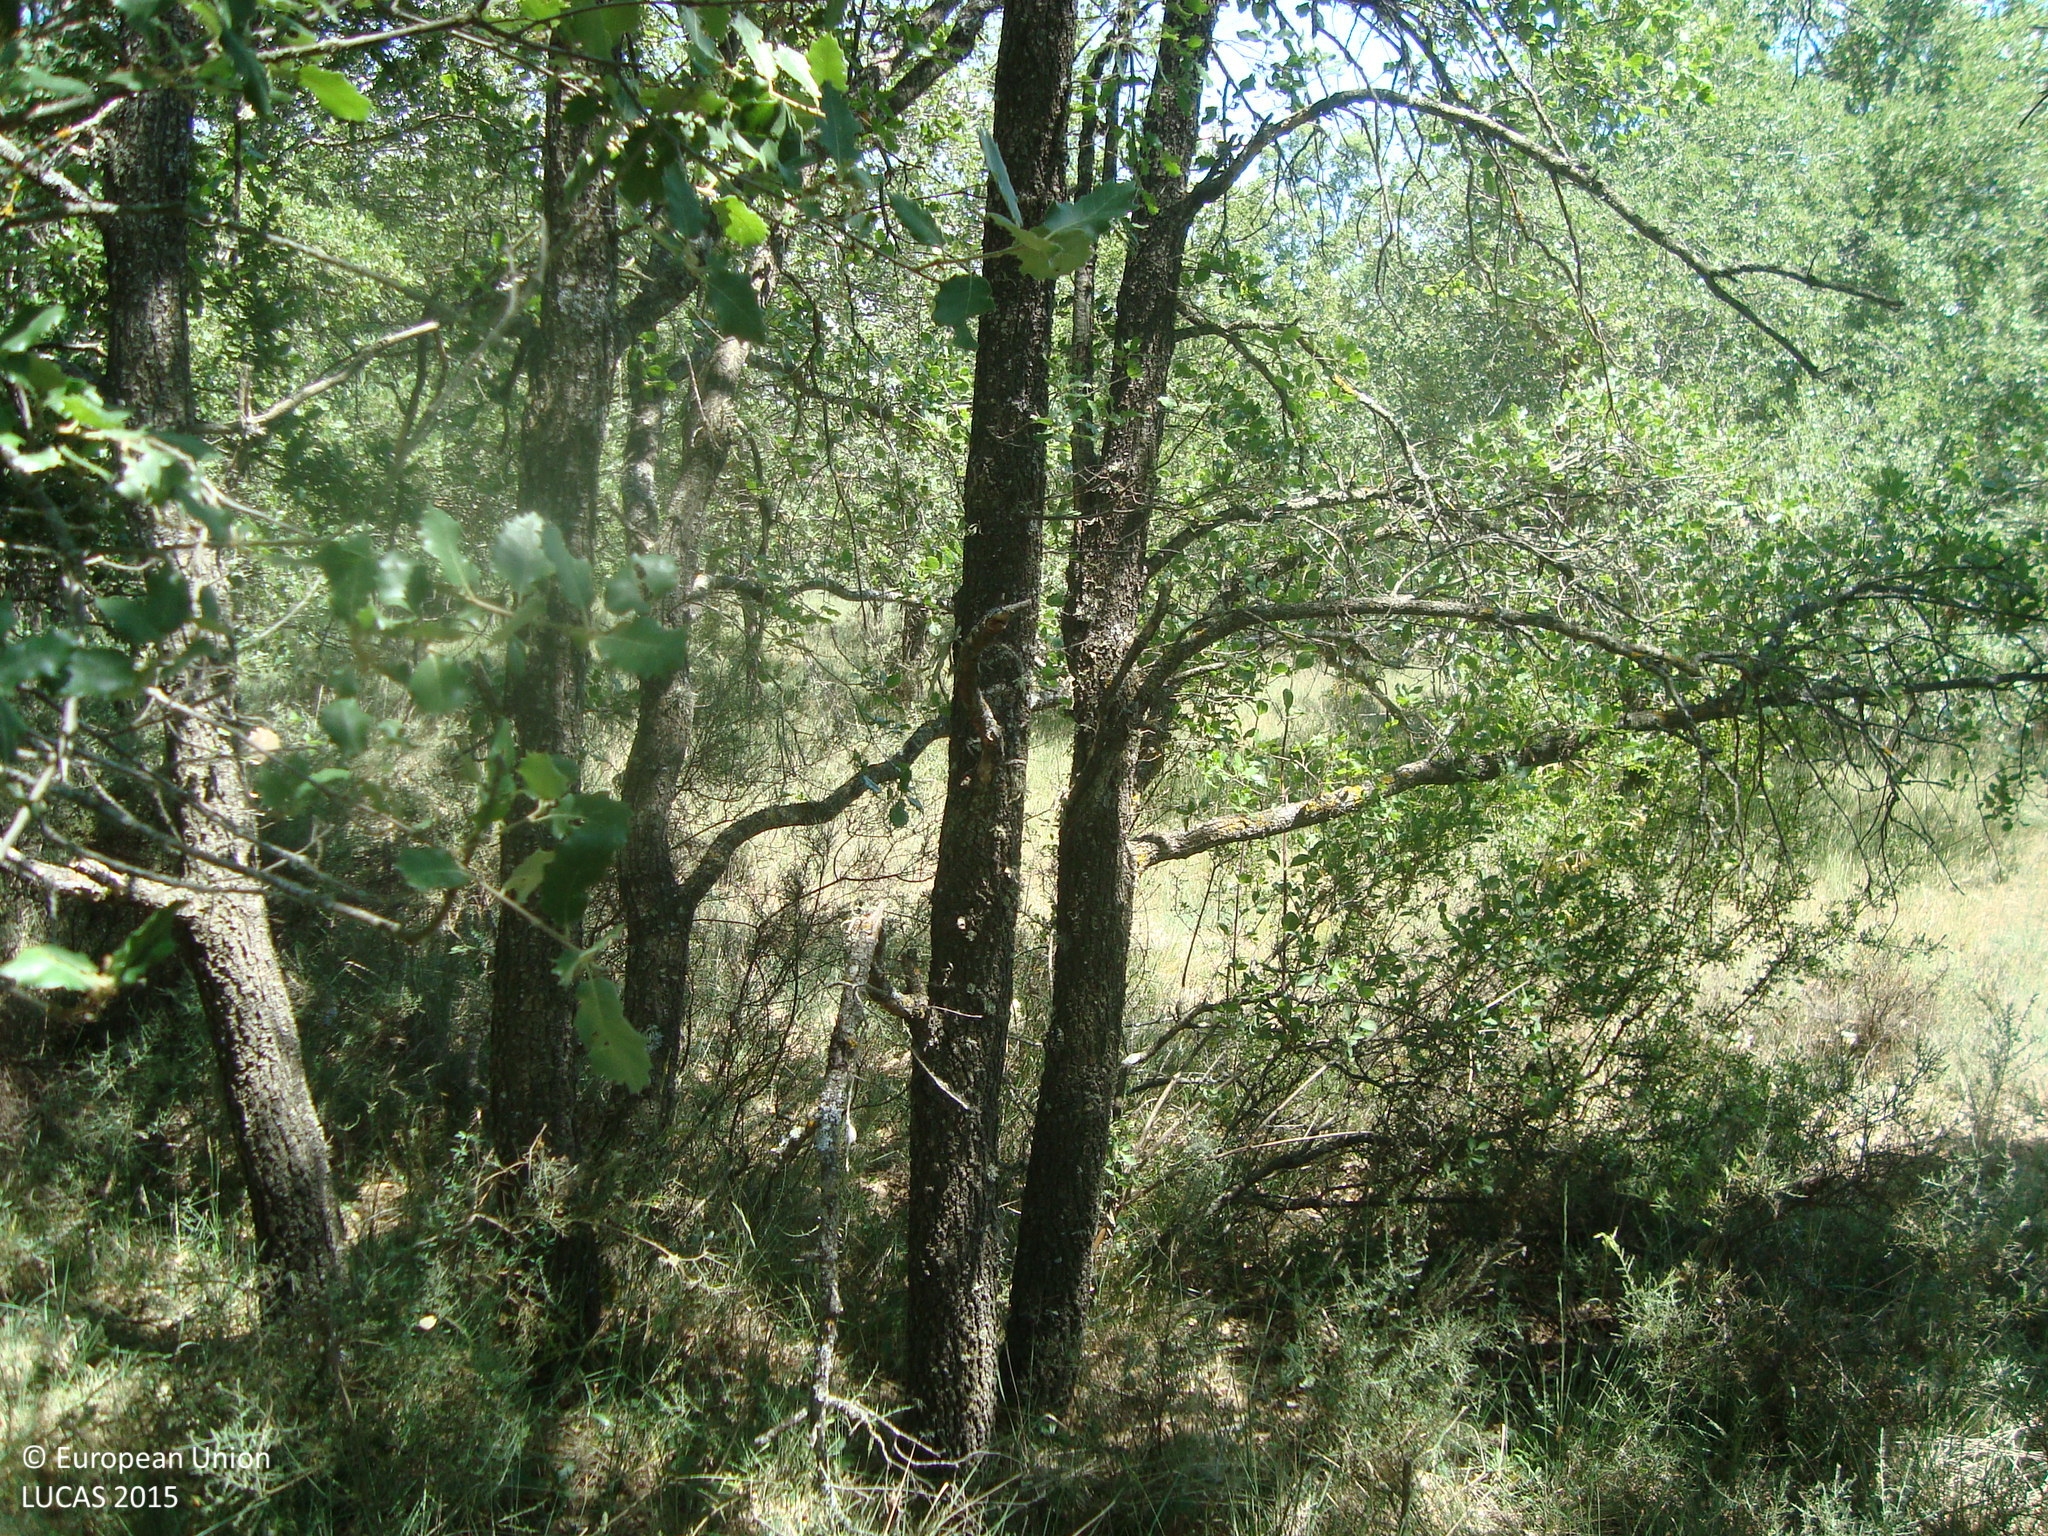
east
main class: Woodland
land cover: Broadleaved woodland
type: thermophilous deciduous forest
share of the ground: 50 - 75 %
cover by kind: broadleaved forest trees 60 %, herbaceous plants 20 %, shrubs 10 %, unconsolidated bare surface 10 %
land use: Forestry
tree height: > 5 m
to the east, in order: Broadleaved woodland; Grassland with sparse tree/shrub cover; Dry stone walls; Grassland with sparse tree/shrub cover; Common wheat; Cherry fruit; Grass margins; Barley
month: June
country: ES
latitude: 41.8302
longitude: -3.5504
